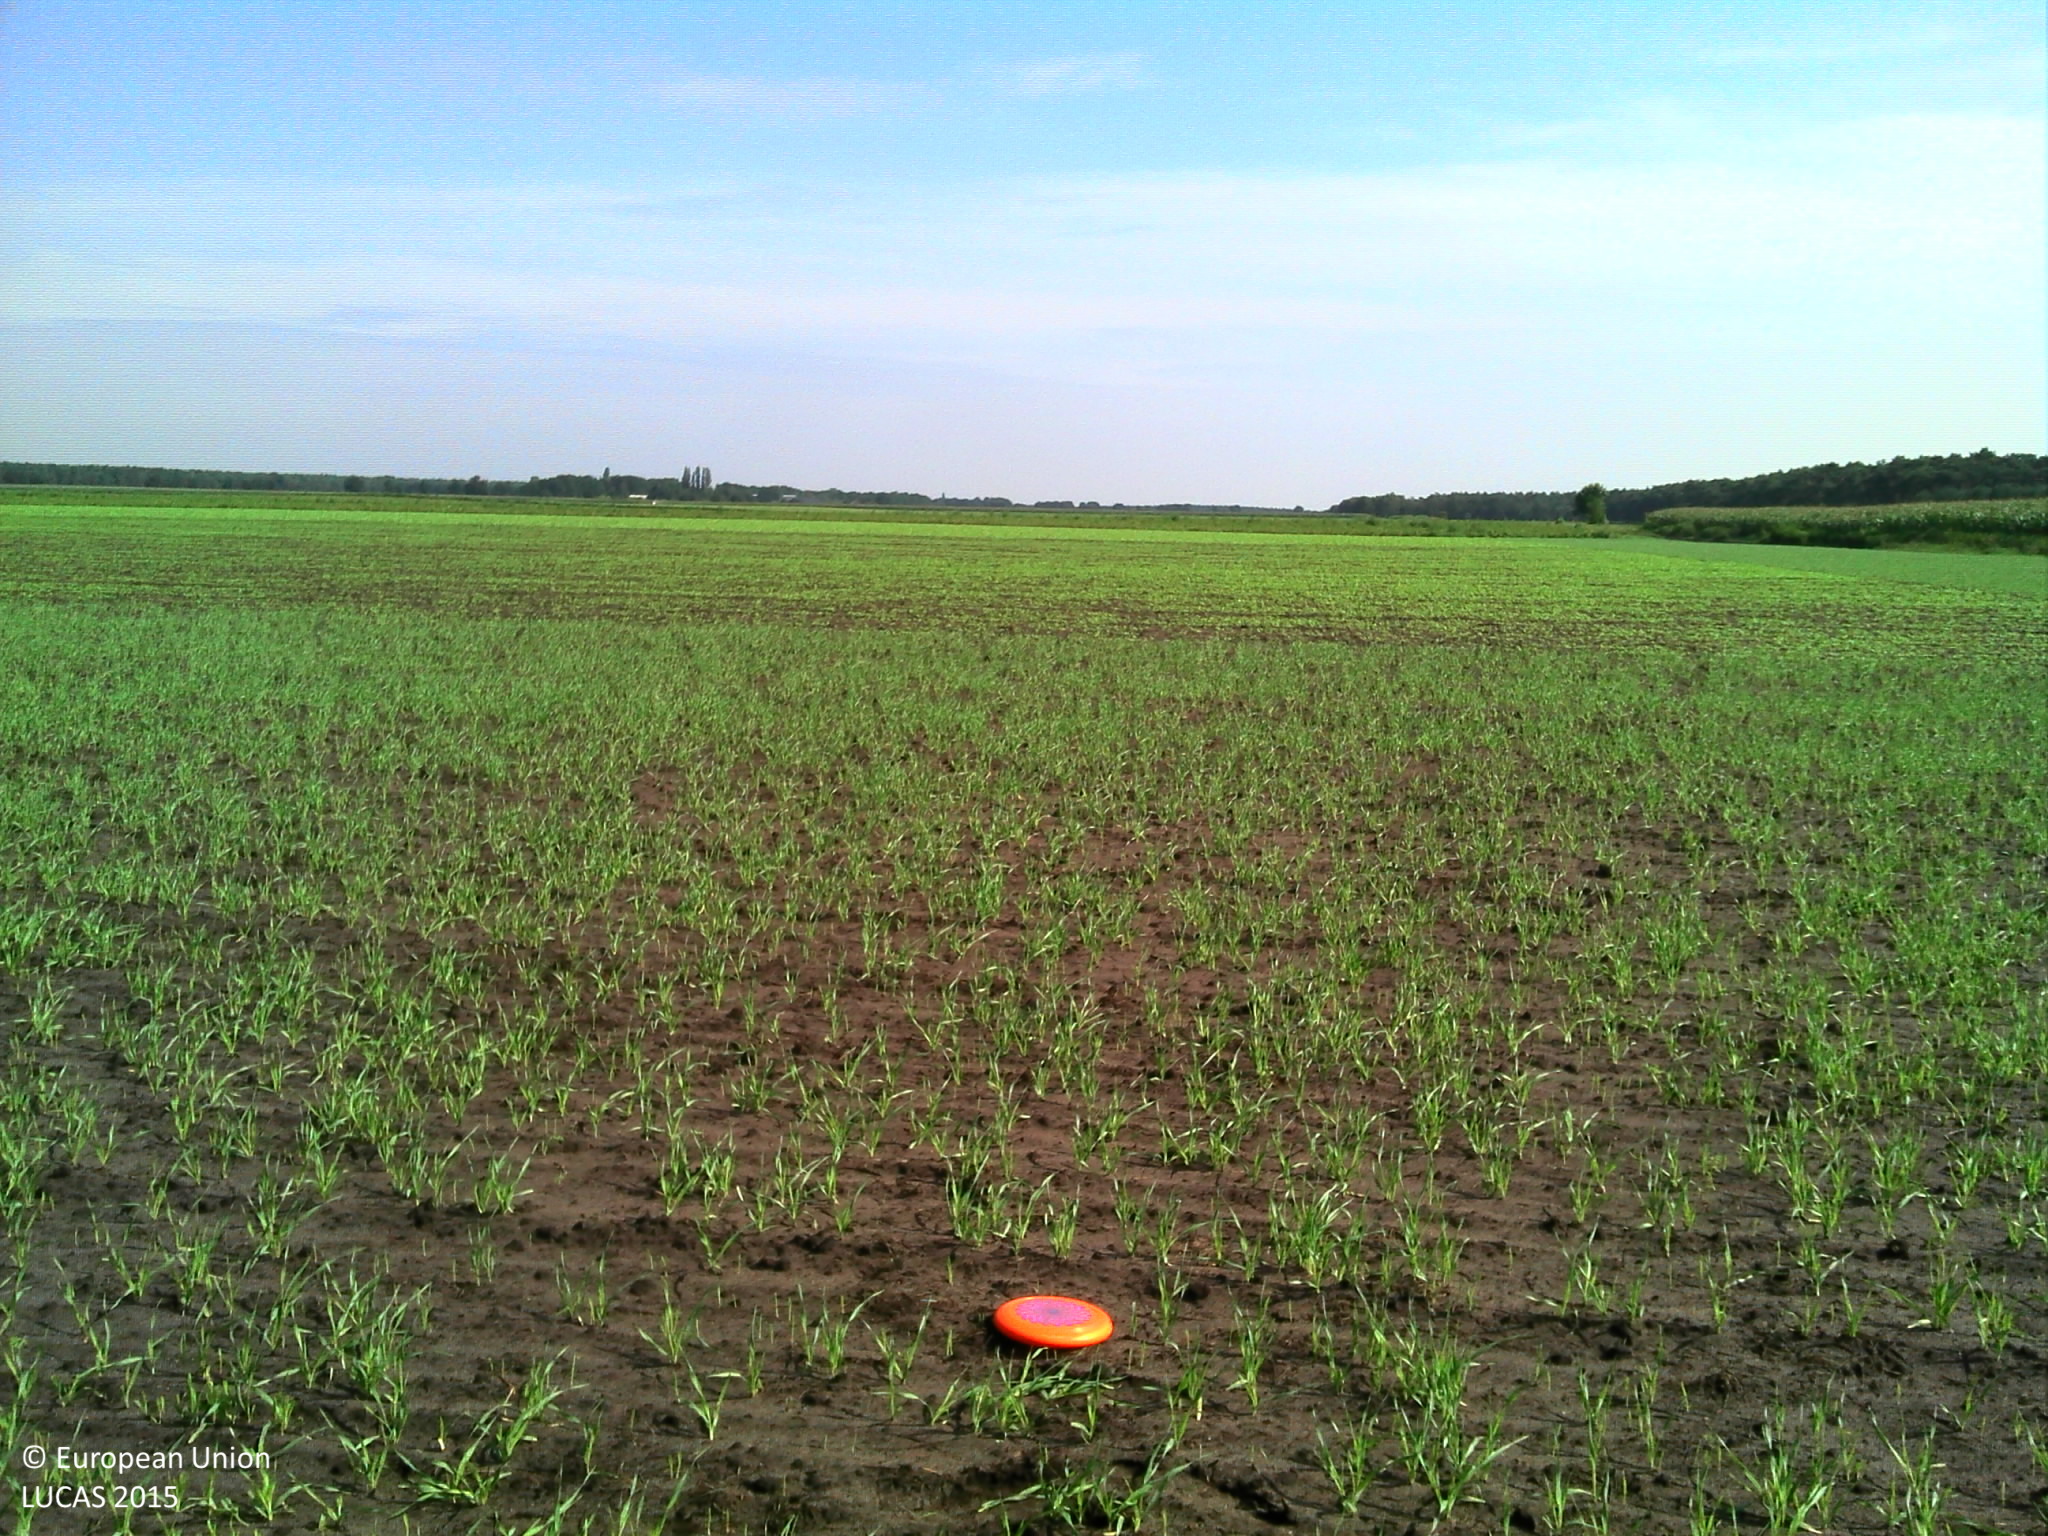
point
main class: Cropland
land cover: Common wheat
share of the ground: < 10 %
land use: Agriculture (excluding fallow land and kitchen gardens)
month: August
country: BE
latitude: 51.2551
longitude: 5.2262
